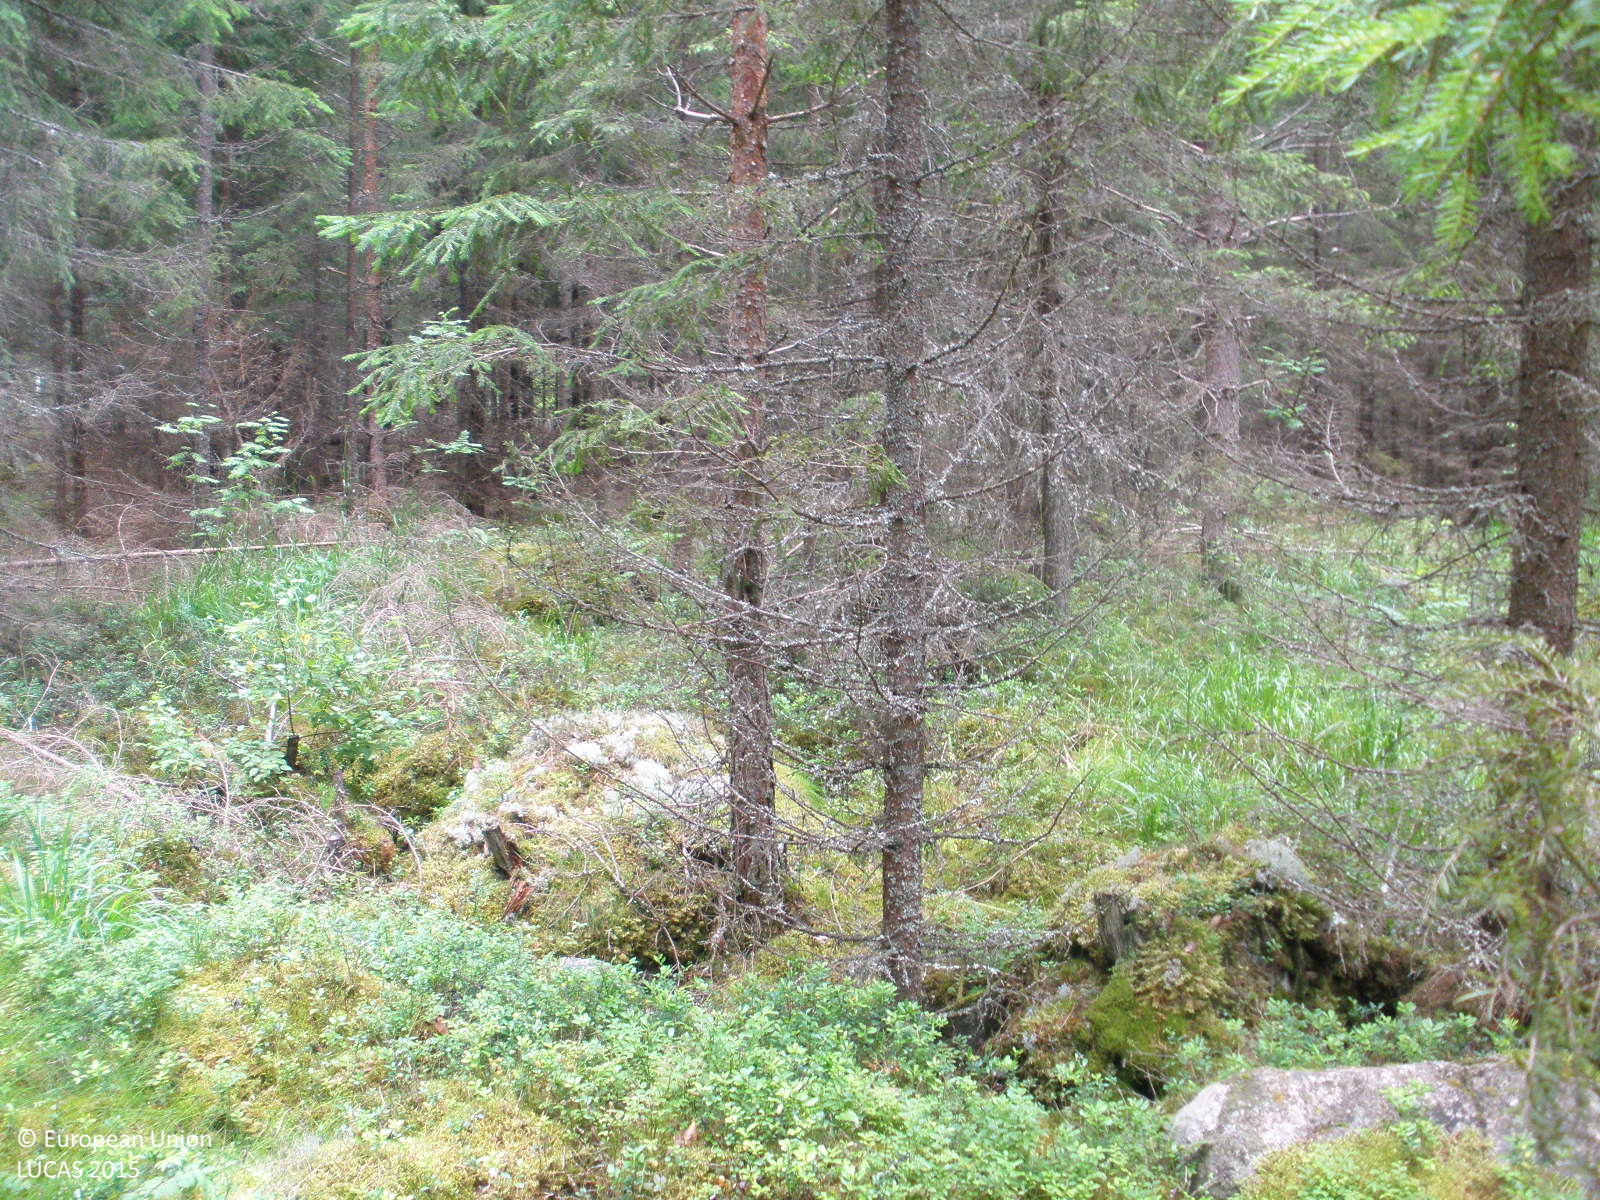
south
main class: Woodland
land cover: Spruce dominated coniferous woodland
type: boreal forest
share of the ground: > 75 %
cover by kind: coniferous forest trees 85 %, lichens and mosses 10 %, herbaceous plants 5 %
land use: Forestry
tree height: > 5 m
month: July
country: FI
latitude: 61.4551
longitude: 24.9475
